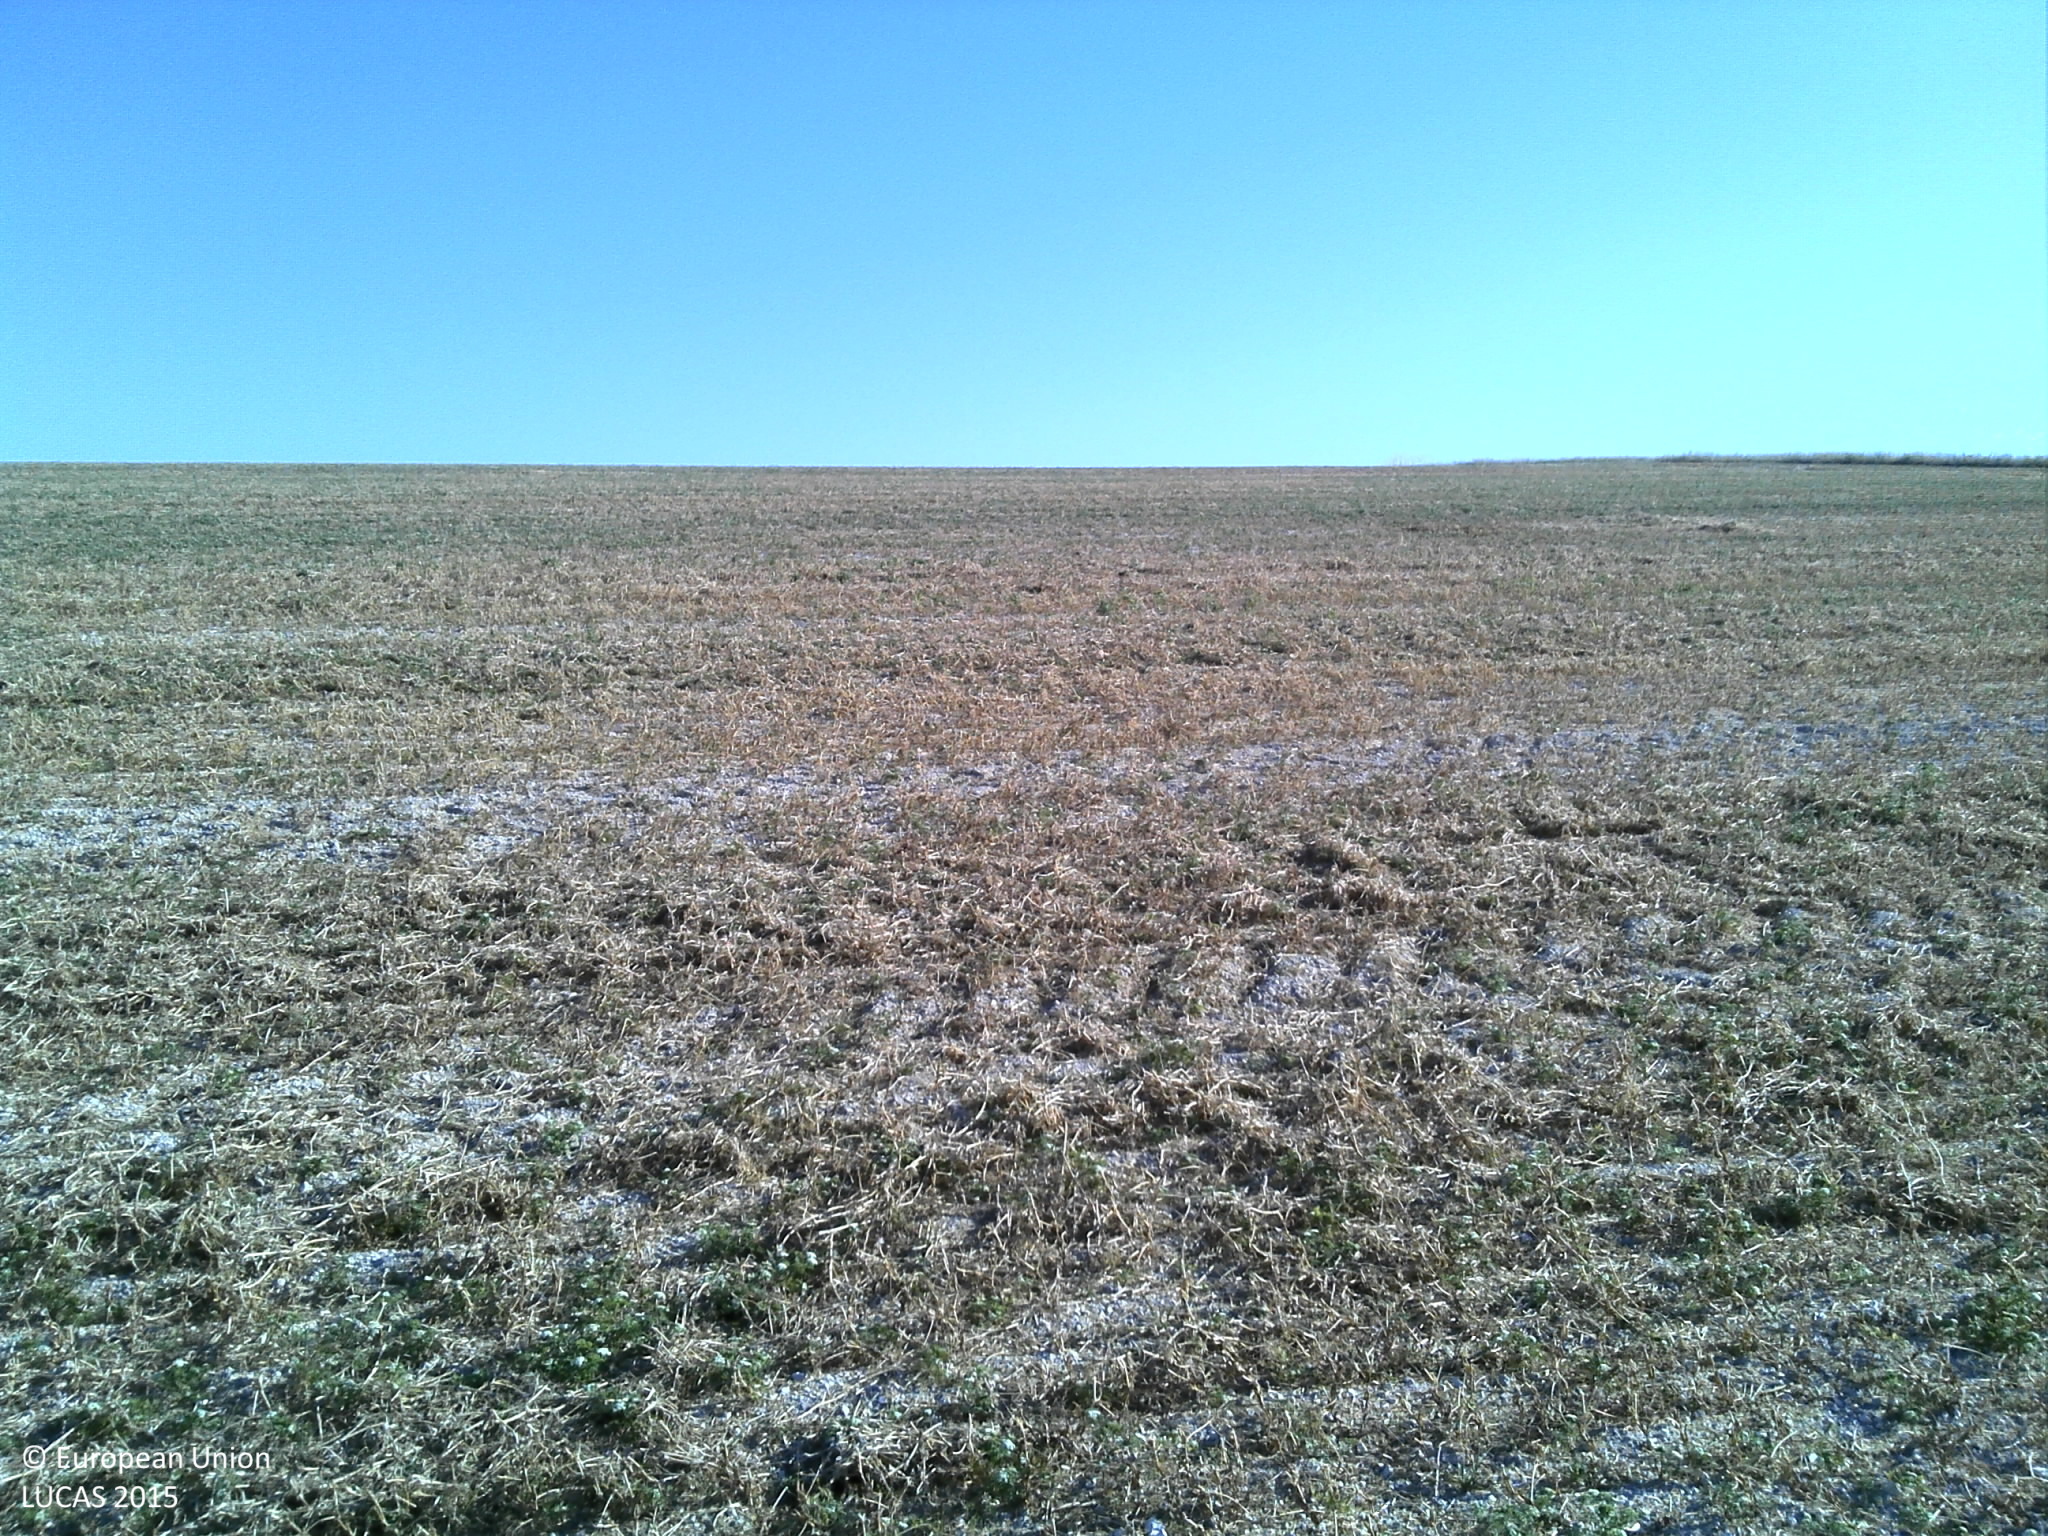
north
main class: Cropland
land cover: Dry pulses
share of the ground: > 75 %
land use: Agriculture (excluding fallow land and kitchen gardens)
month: August
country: FR
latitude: 49.1261
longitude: 4.7487
